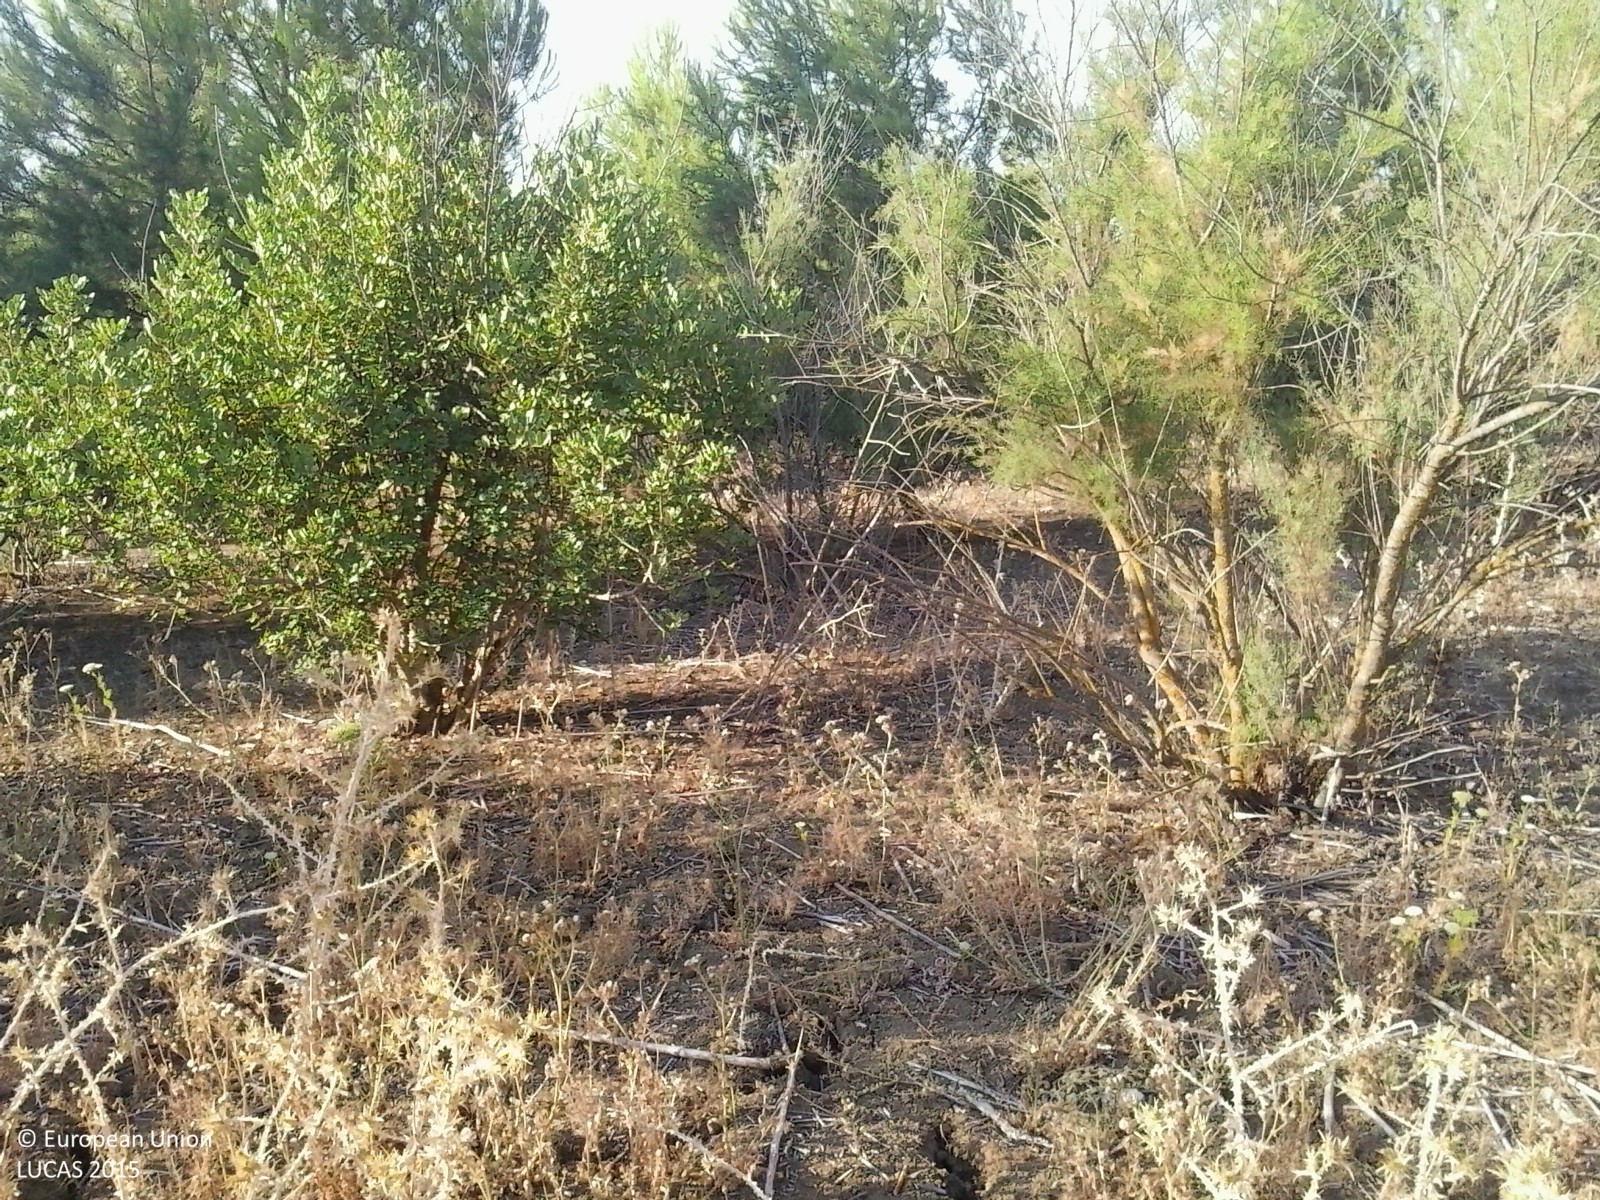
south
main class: Woodland
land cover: Pine dominated coniferous woodland
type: coniferous forest of the mediterranean region
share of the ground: 25 - 50 %
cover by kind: shrubs 50 %, coniferous forest trees 30 %, herbaceous plants 20 %
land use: Forestry
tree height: > 5 m
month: July
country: ES
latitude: 36.9481
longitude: -6.0403
